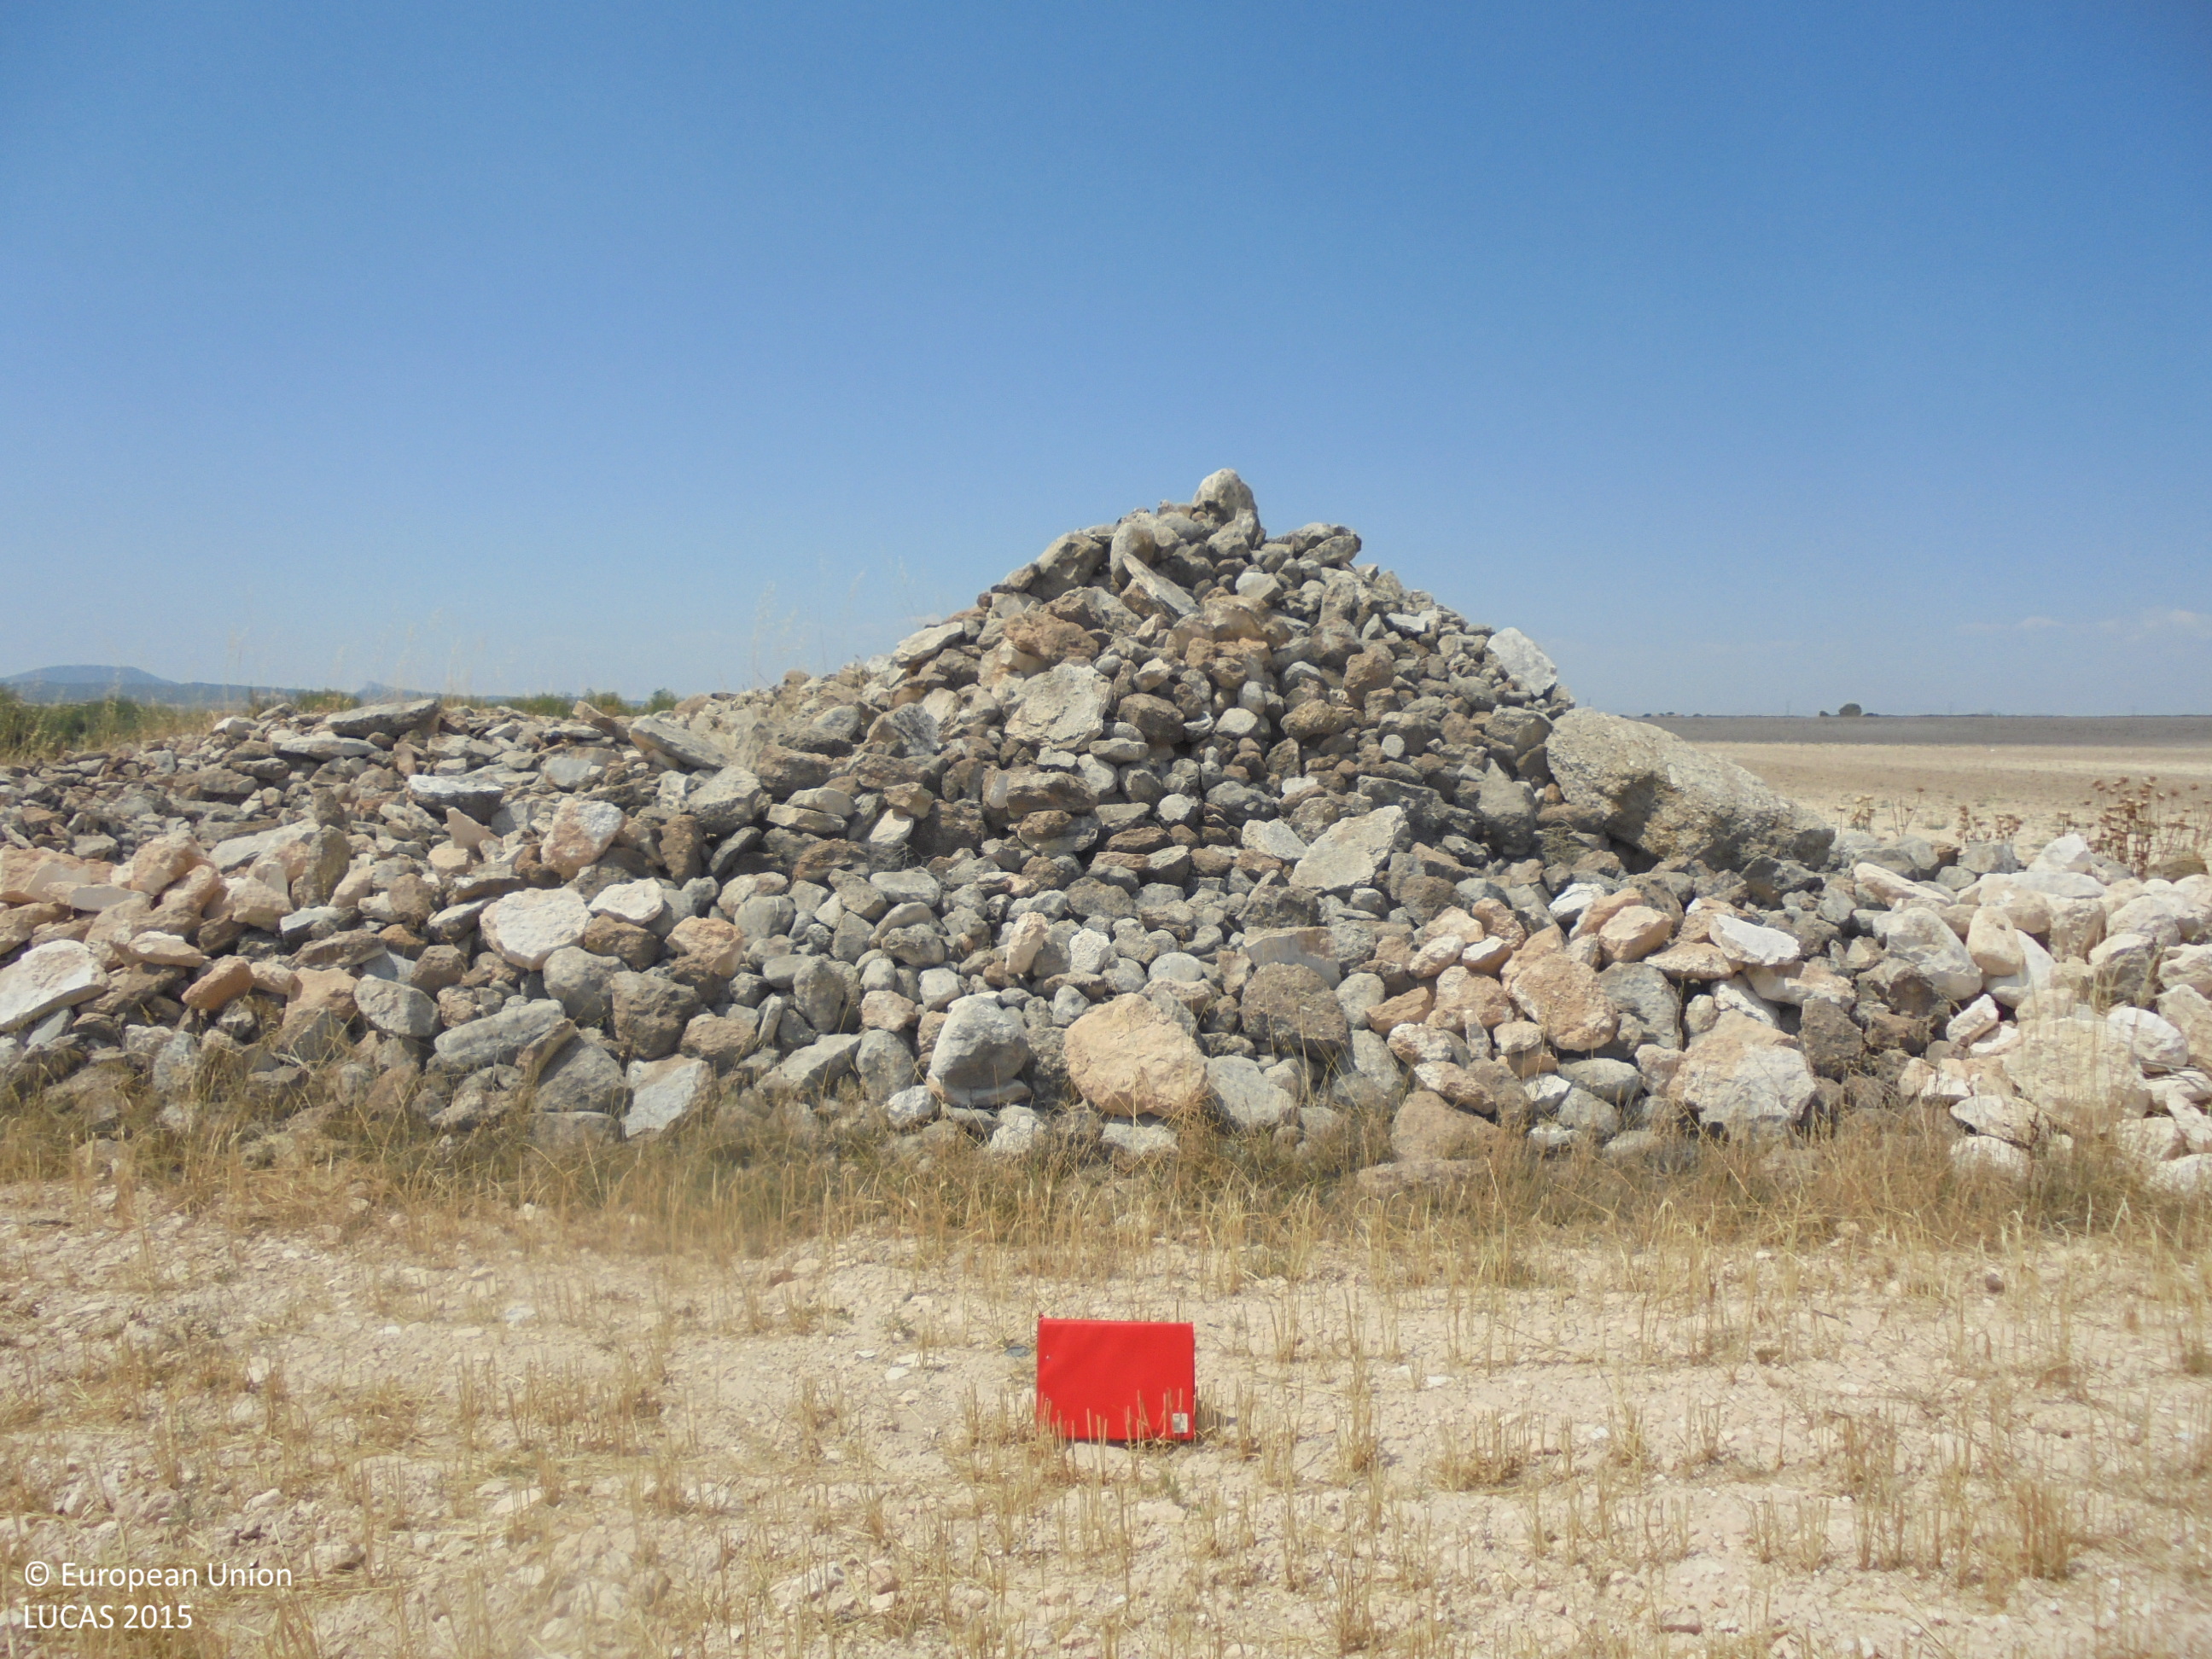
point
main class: Cropland
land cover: Barley
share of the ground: < 10 %
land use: Agriculture (excluding fallow land and kitchen gardens)
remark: Harvested field
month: July
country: ES
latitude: 38.5966
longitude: -1.3940
